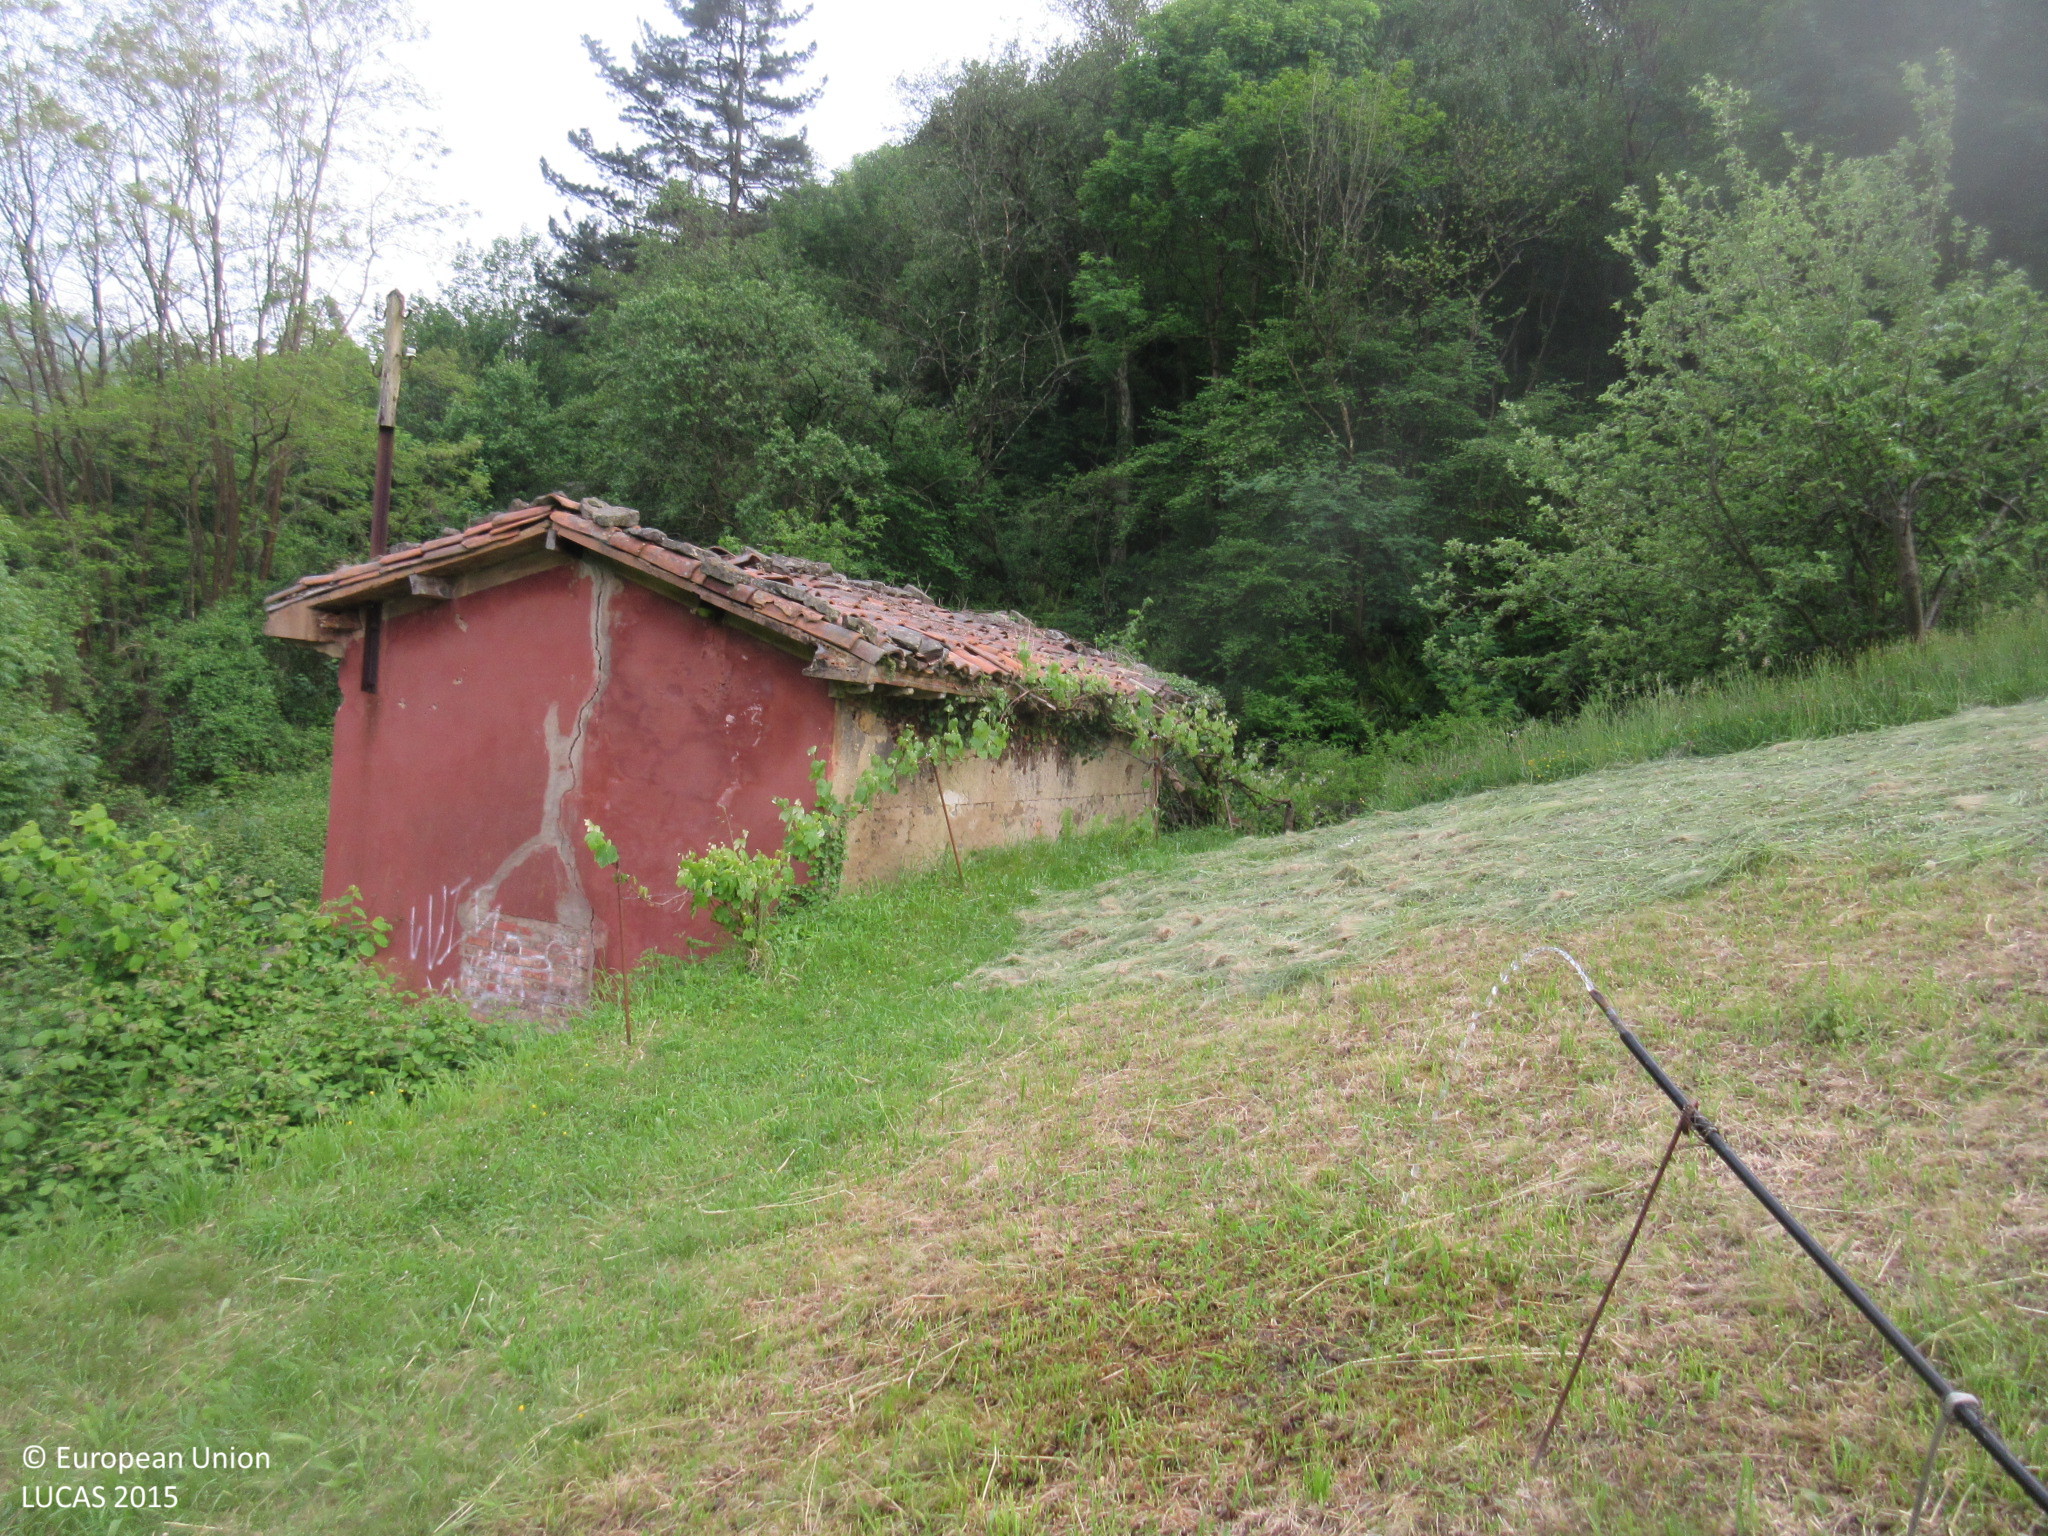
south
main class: Grassland
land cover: Grassland without tree/shrub cover
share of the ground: > 75 %
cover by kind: herbaceous plants 100 %
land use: Agriculture (excluding fallow land and kitchen gardens)
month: May
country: ES
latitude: 43.3083
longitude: -5.6033
